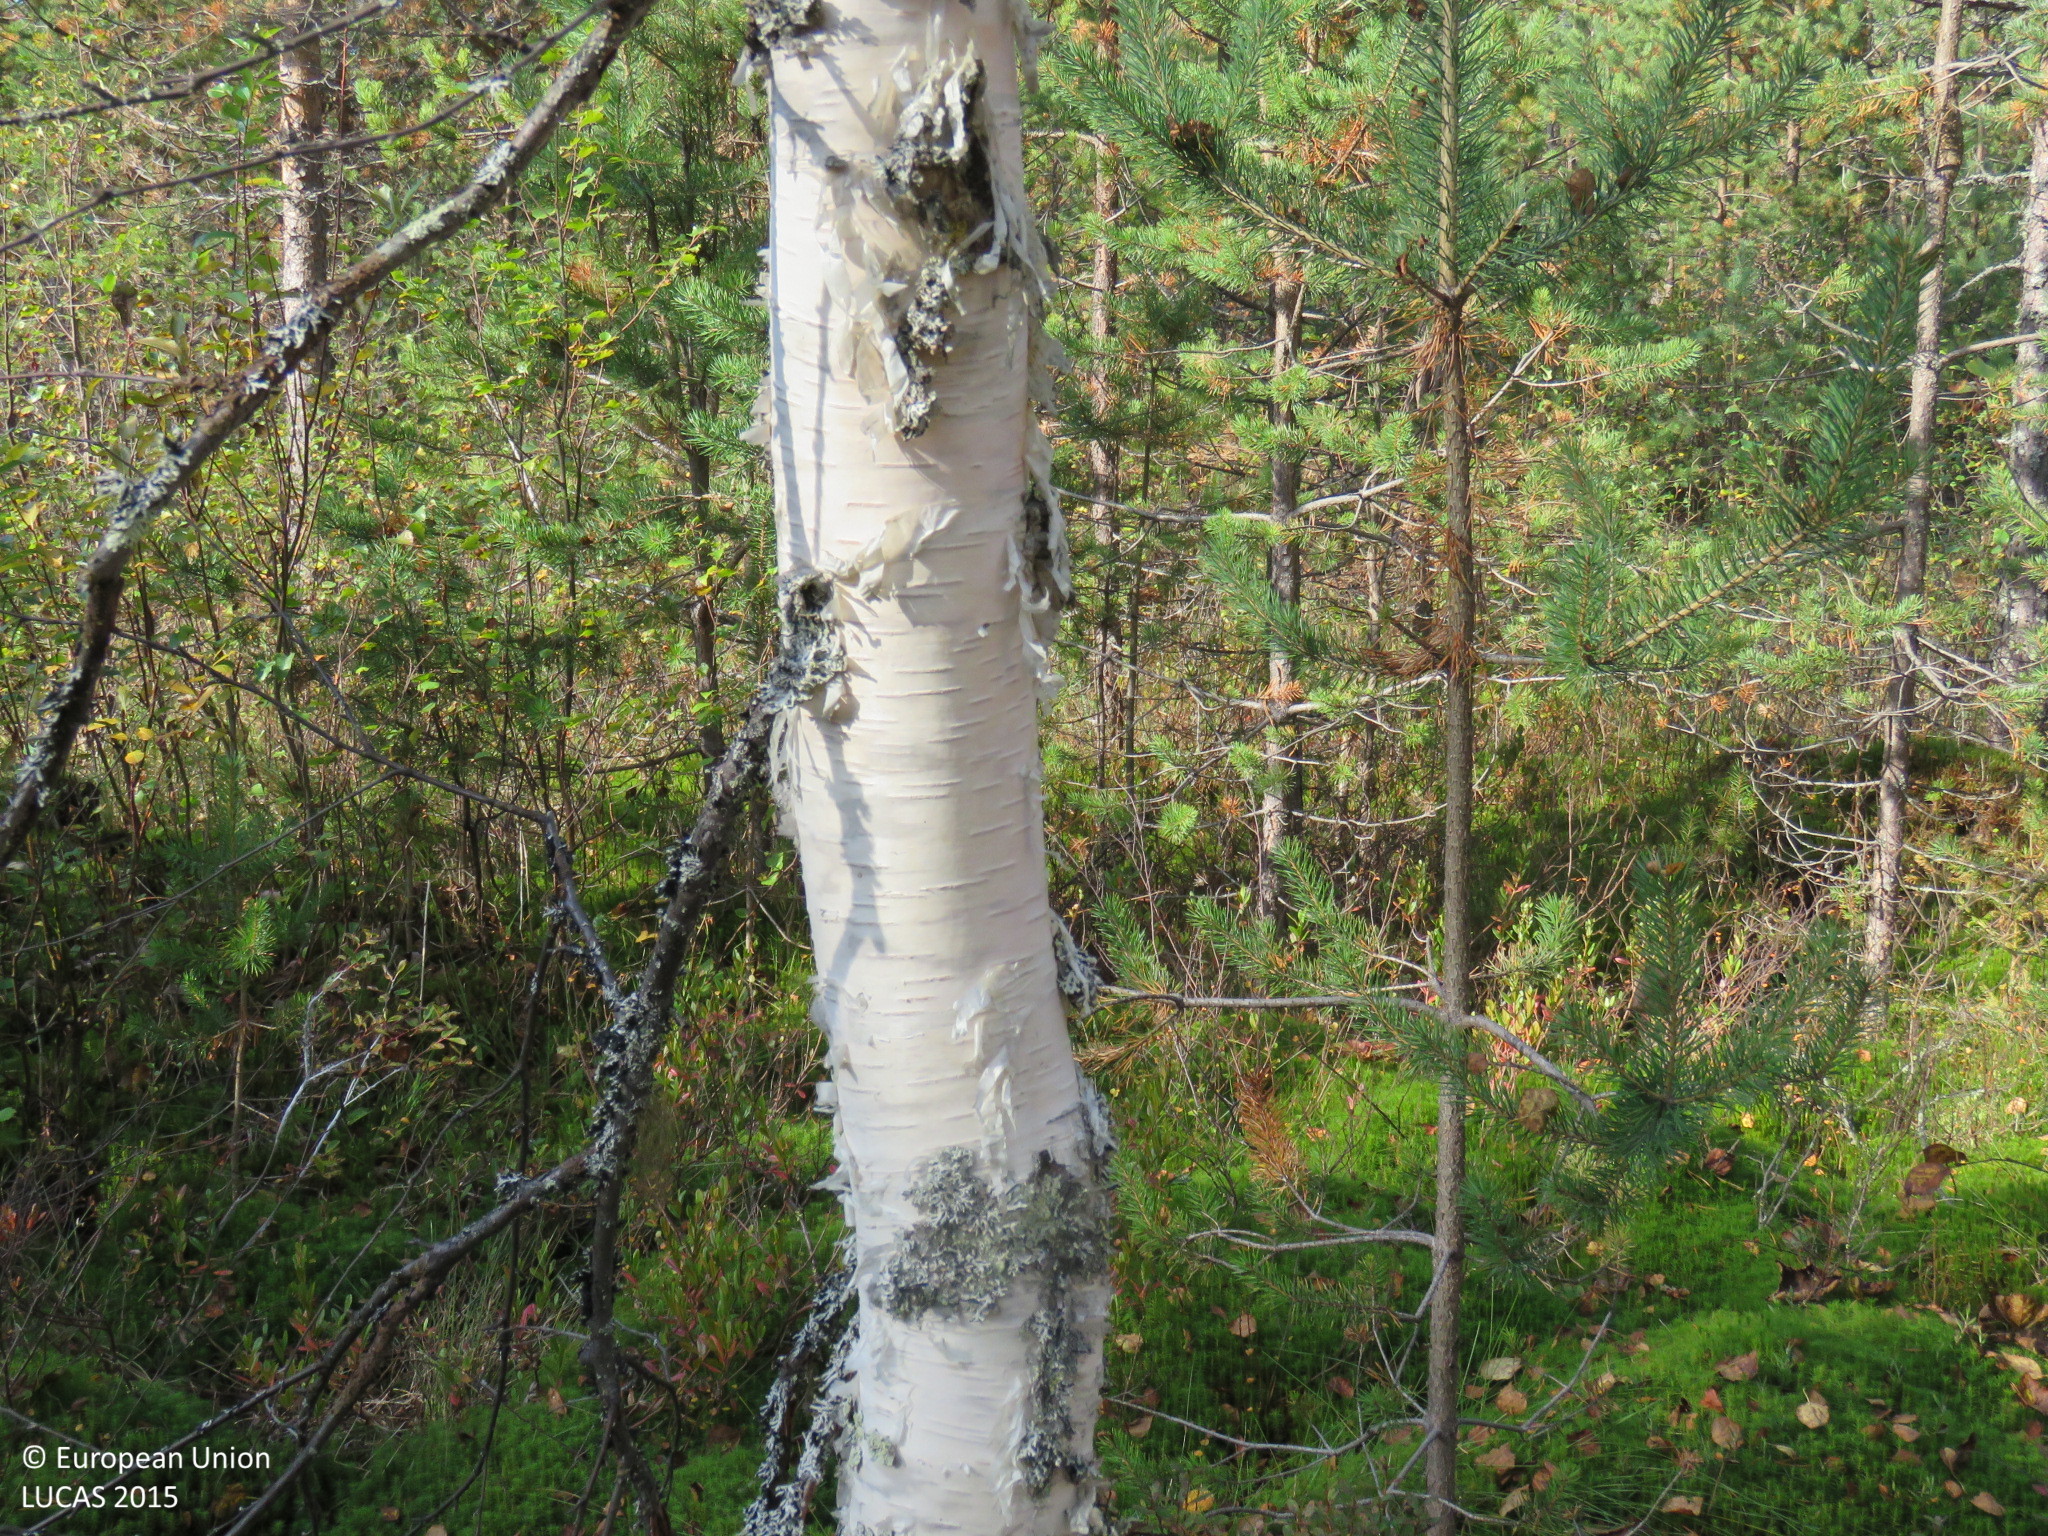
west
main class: Woodland
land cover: Pine dominated mixed woodland
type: mire and swamp forests
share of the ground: > 75 %
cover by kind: broadleaved forest trees 50 %, coniferous forest trees 30 %, shrubs 15 %, lichens and mosses 5 %
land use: Forestry
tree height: > 5 m
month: September
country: FI
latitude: 65.0828
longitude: 26.5083
